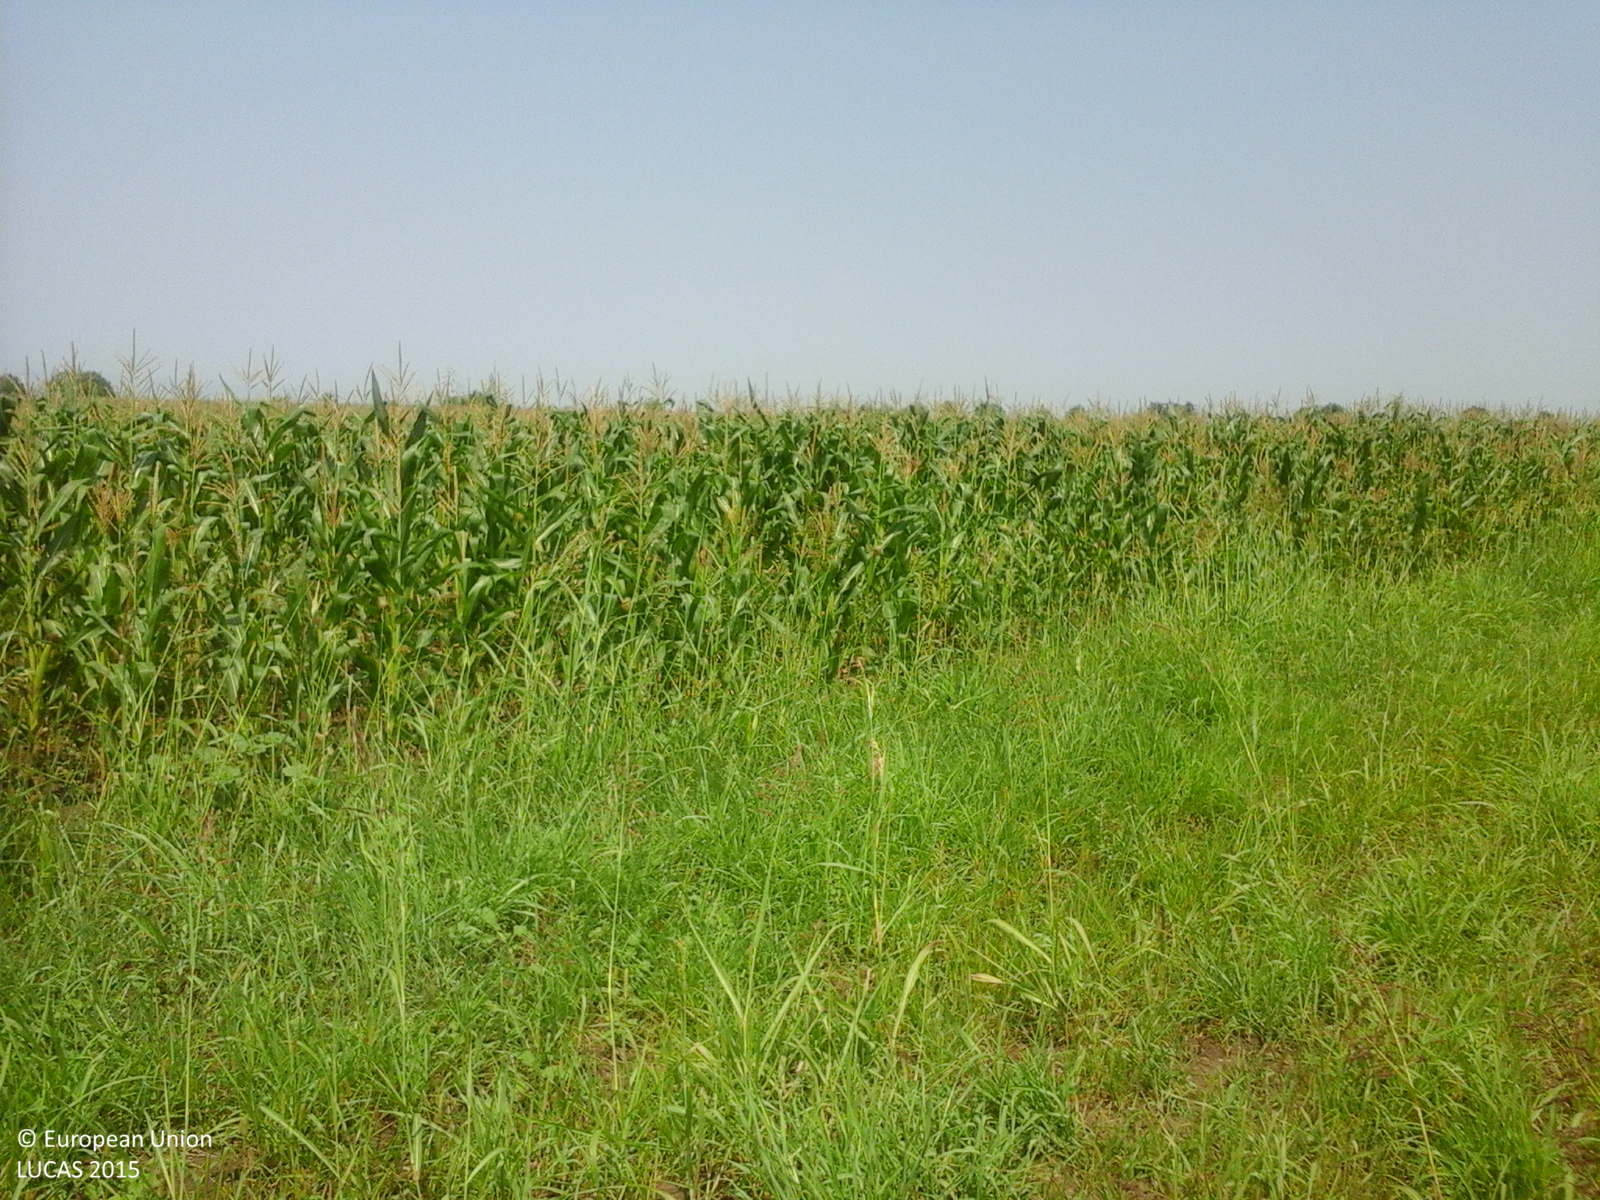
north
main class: Grassland
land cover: Grassland without tree/shrub cover
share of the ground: > 75 %
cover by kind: herbaceous plants 100 %
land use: Agriculture (excluding fallow land and kitchen gardens)
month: July
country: RO
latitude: 44.8530
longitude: 26.6357
